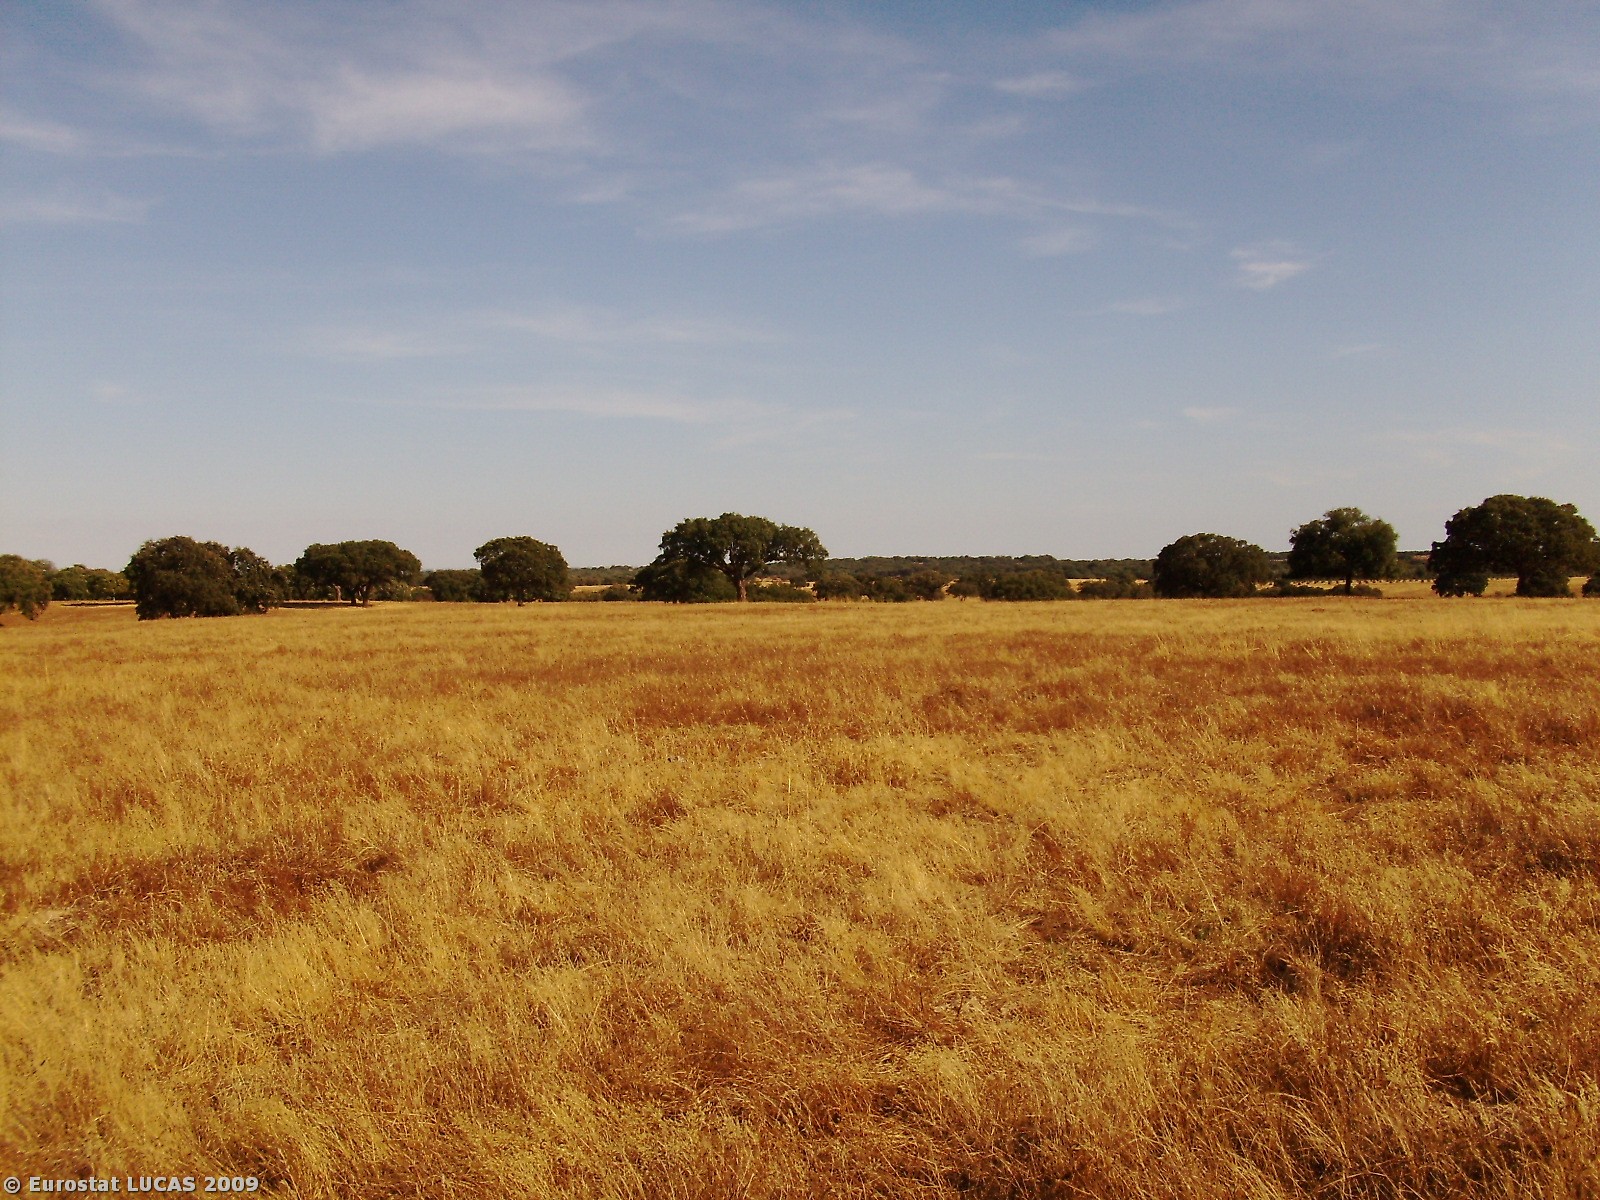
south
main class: Grassland
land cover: Grassland without tree/shrub cover
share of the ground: > 75 %
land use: Agriculture (excluding fallow land and kitchen gardens)
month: June
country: PT
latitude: 37.9991
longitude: -8.3625
